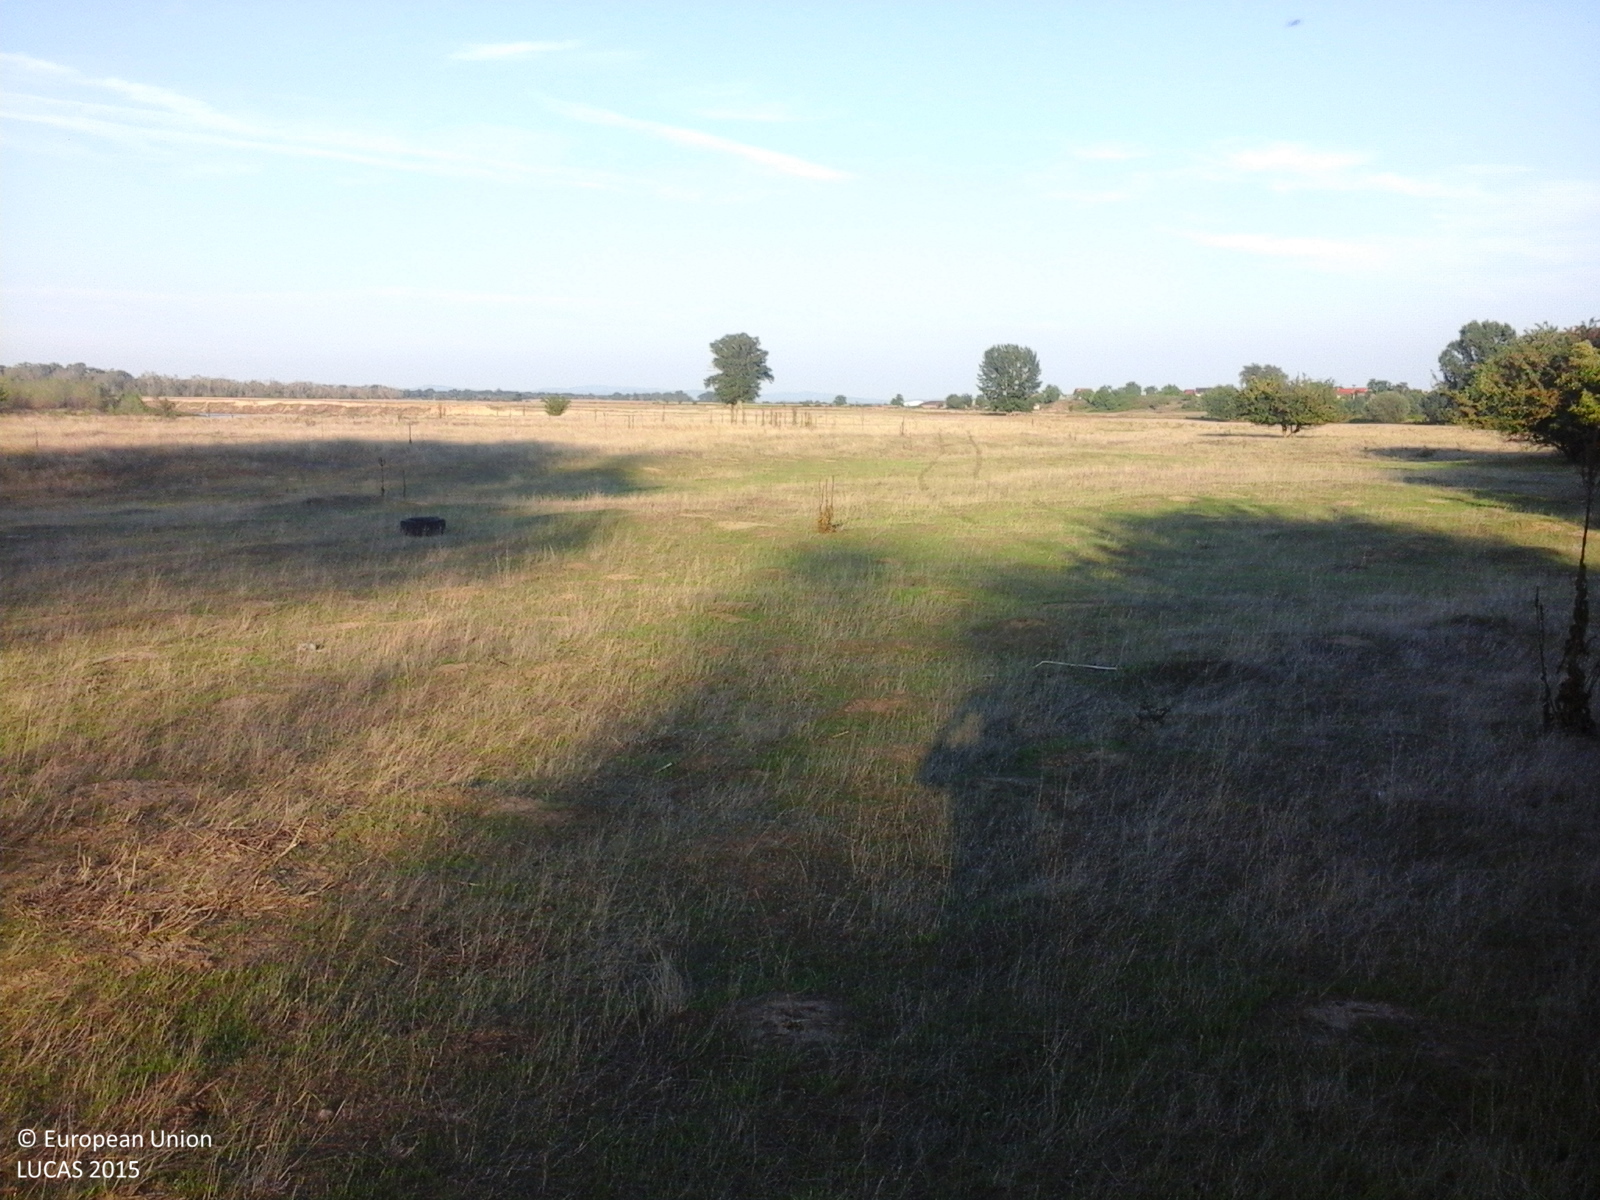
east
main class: Grassland
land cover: Grassland with sparse tree/shrub cover
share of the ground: > 75 %
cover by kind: herbaceous plants 85 %, shrubs 10 %, broadleaved forest trees 5 %
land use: Agriculture (excluding fallow land and kitchen gardens)
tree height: < 5 m
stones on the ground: < 10 %
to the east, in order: Grassland with sparse tree/shrub cover; Grassland without tree/shrub cover
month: August
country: RO
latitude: 46.1422
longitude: 21.2045
